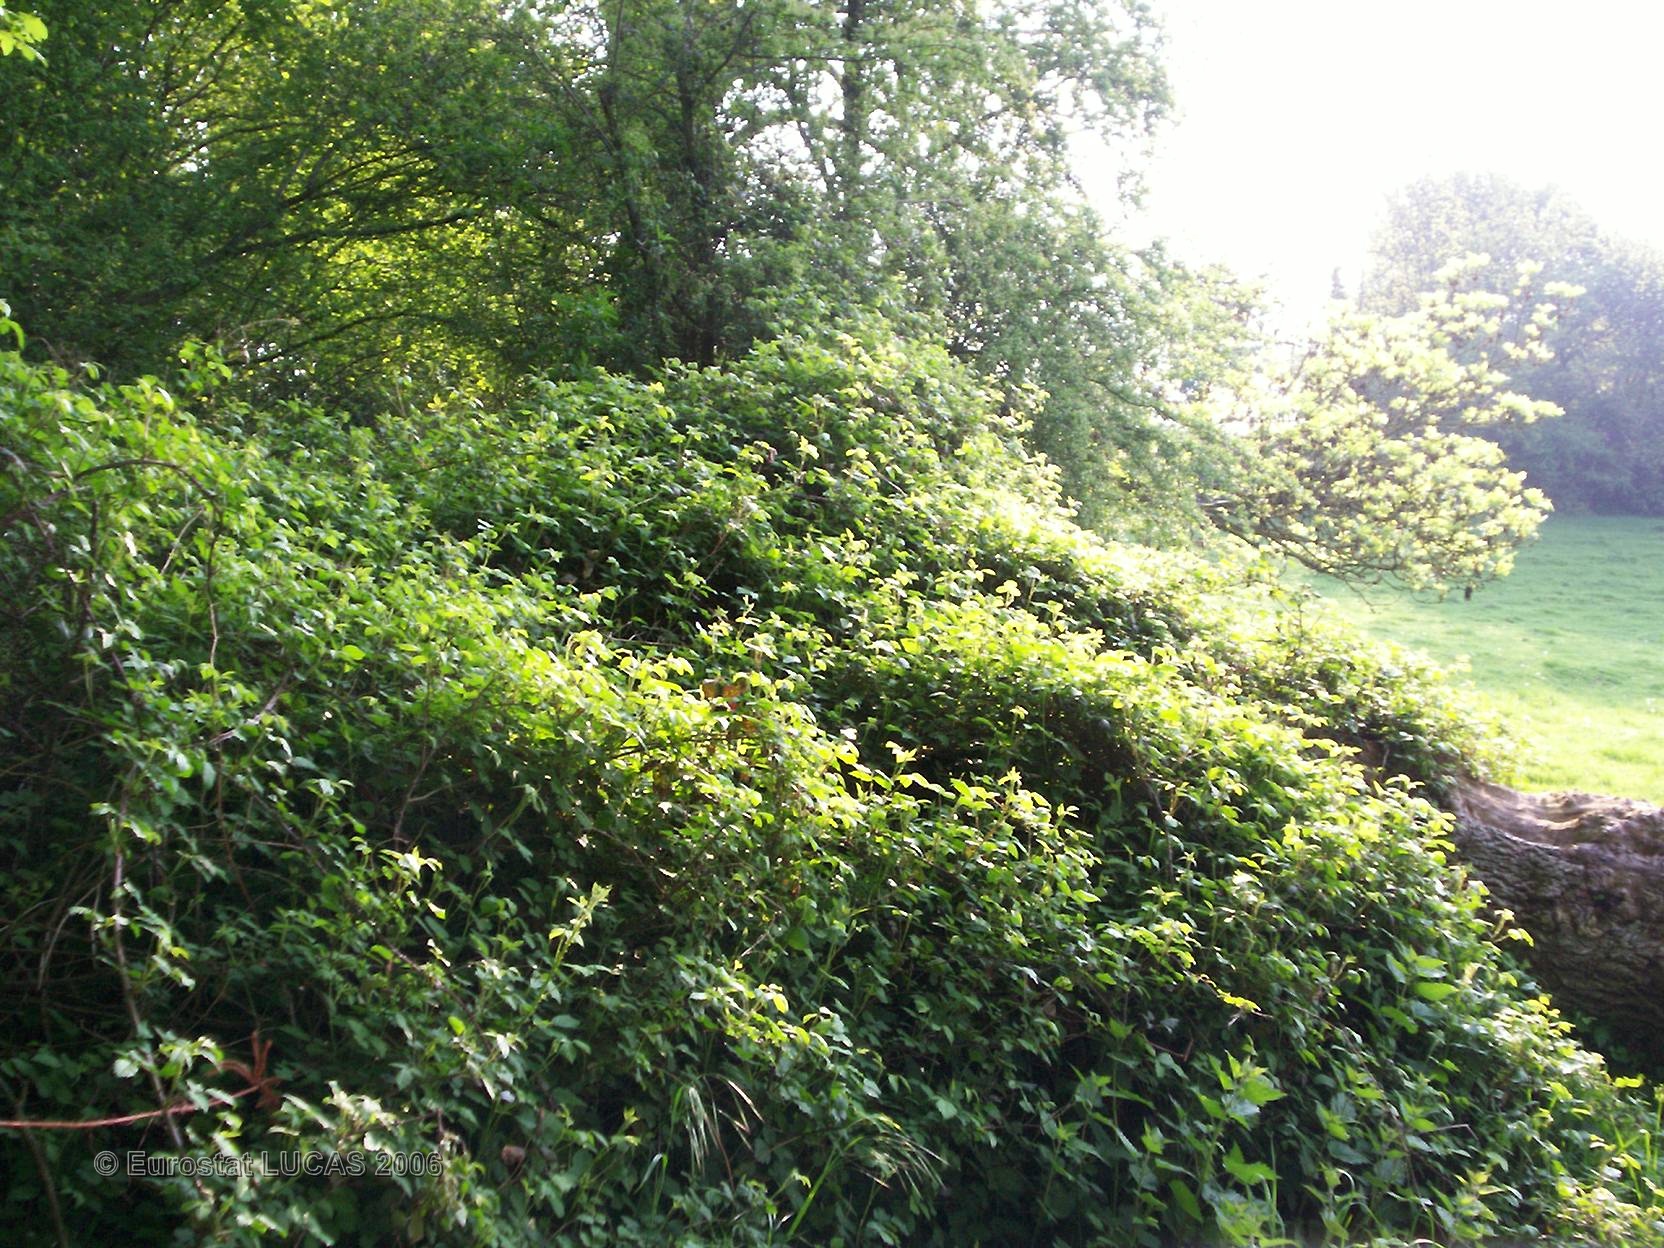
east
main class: Grassland
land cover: Grassland without tree/shrub cover
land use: Agriculture (excluding fallow land and kitchen gardens)
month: May
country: FR
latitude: 48.5903
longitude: 0.2791
